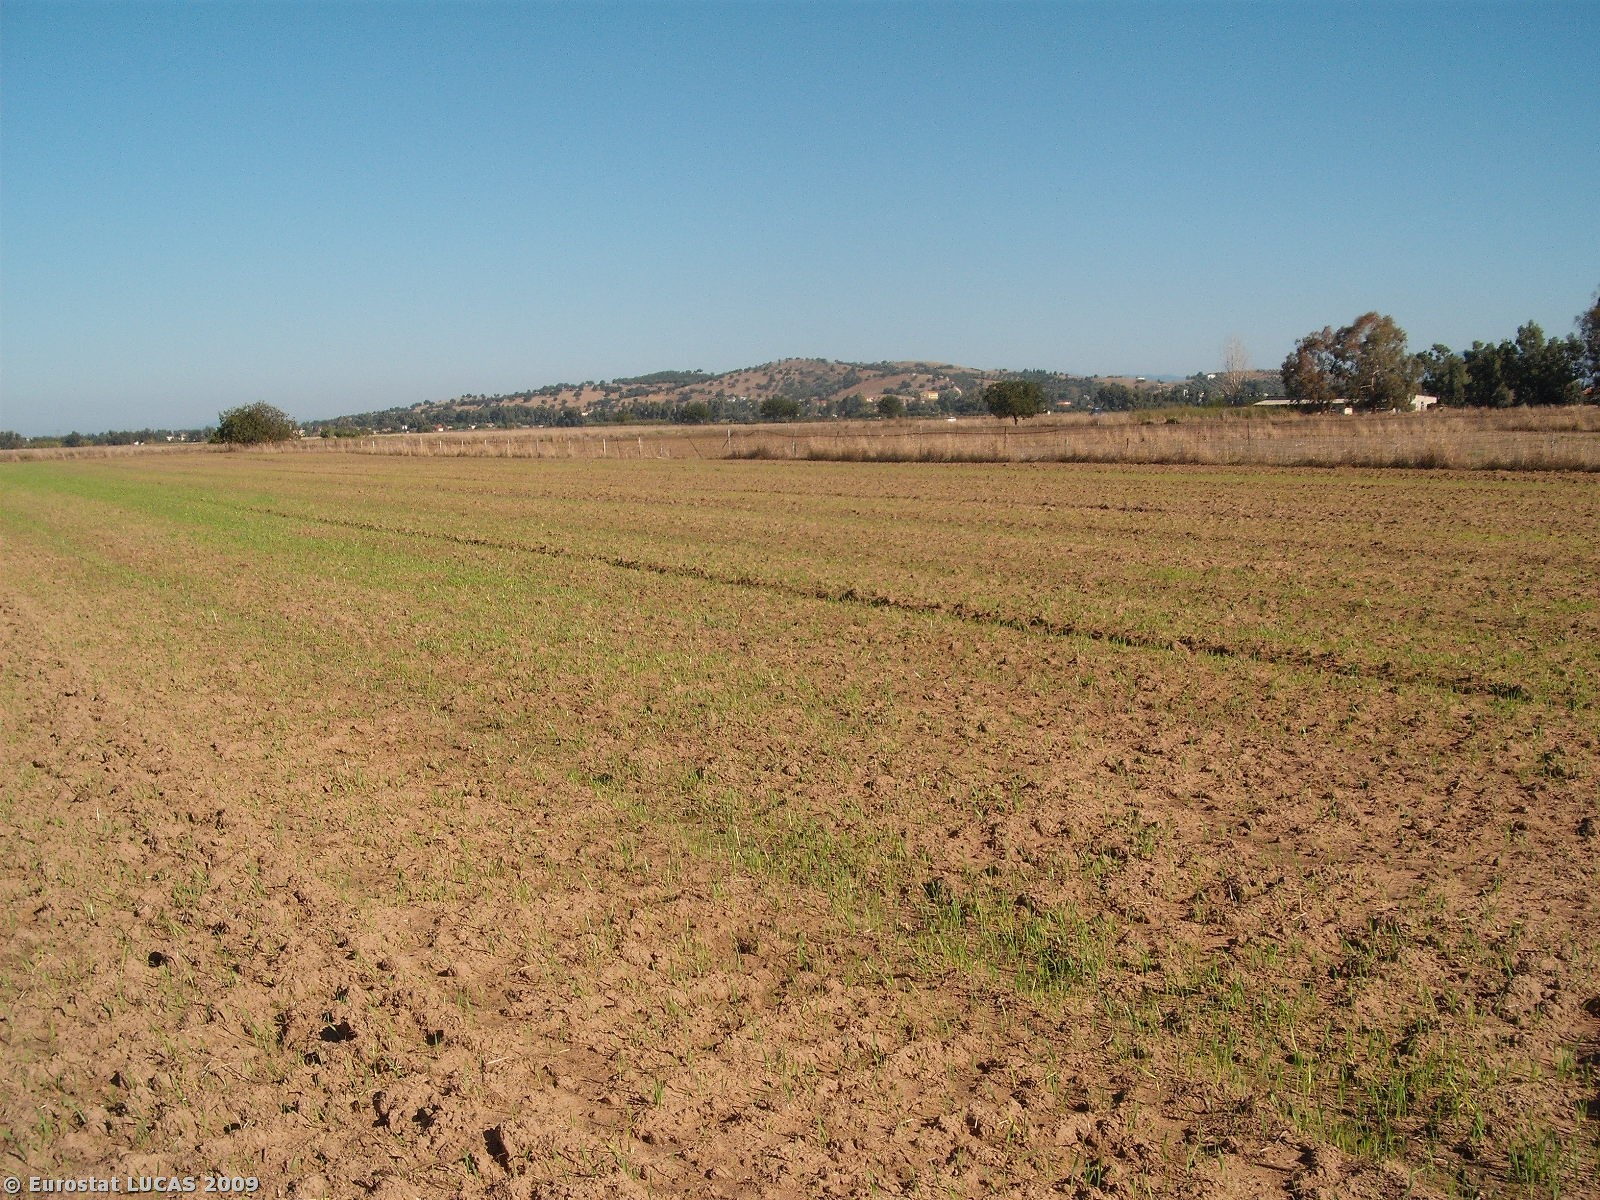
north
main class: Cropland
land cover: Mixed cereals for fodder
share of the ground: < 10 %
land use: Agriculture (excluding fallow land and kitchen gardens)
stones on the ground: < 10 %
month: October
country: GR
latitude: 38.1505
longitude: 21.4559
